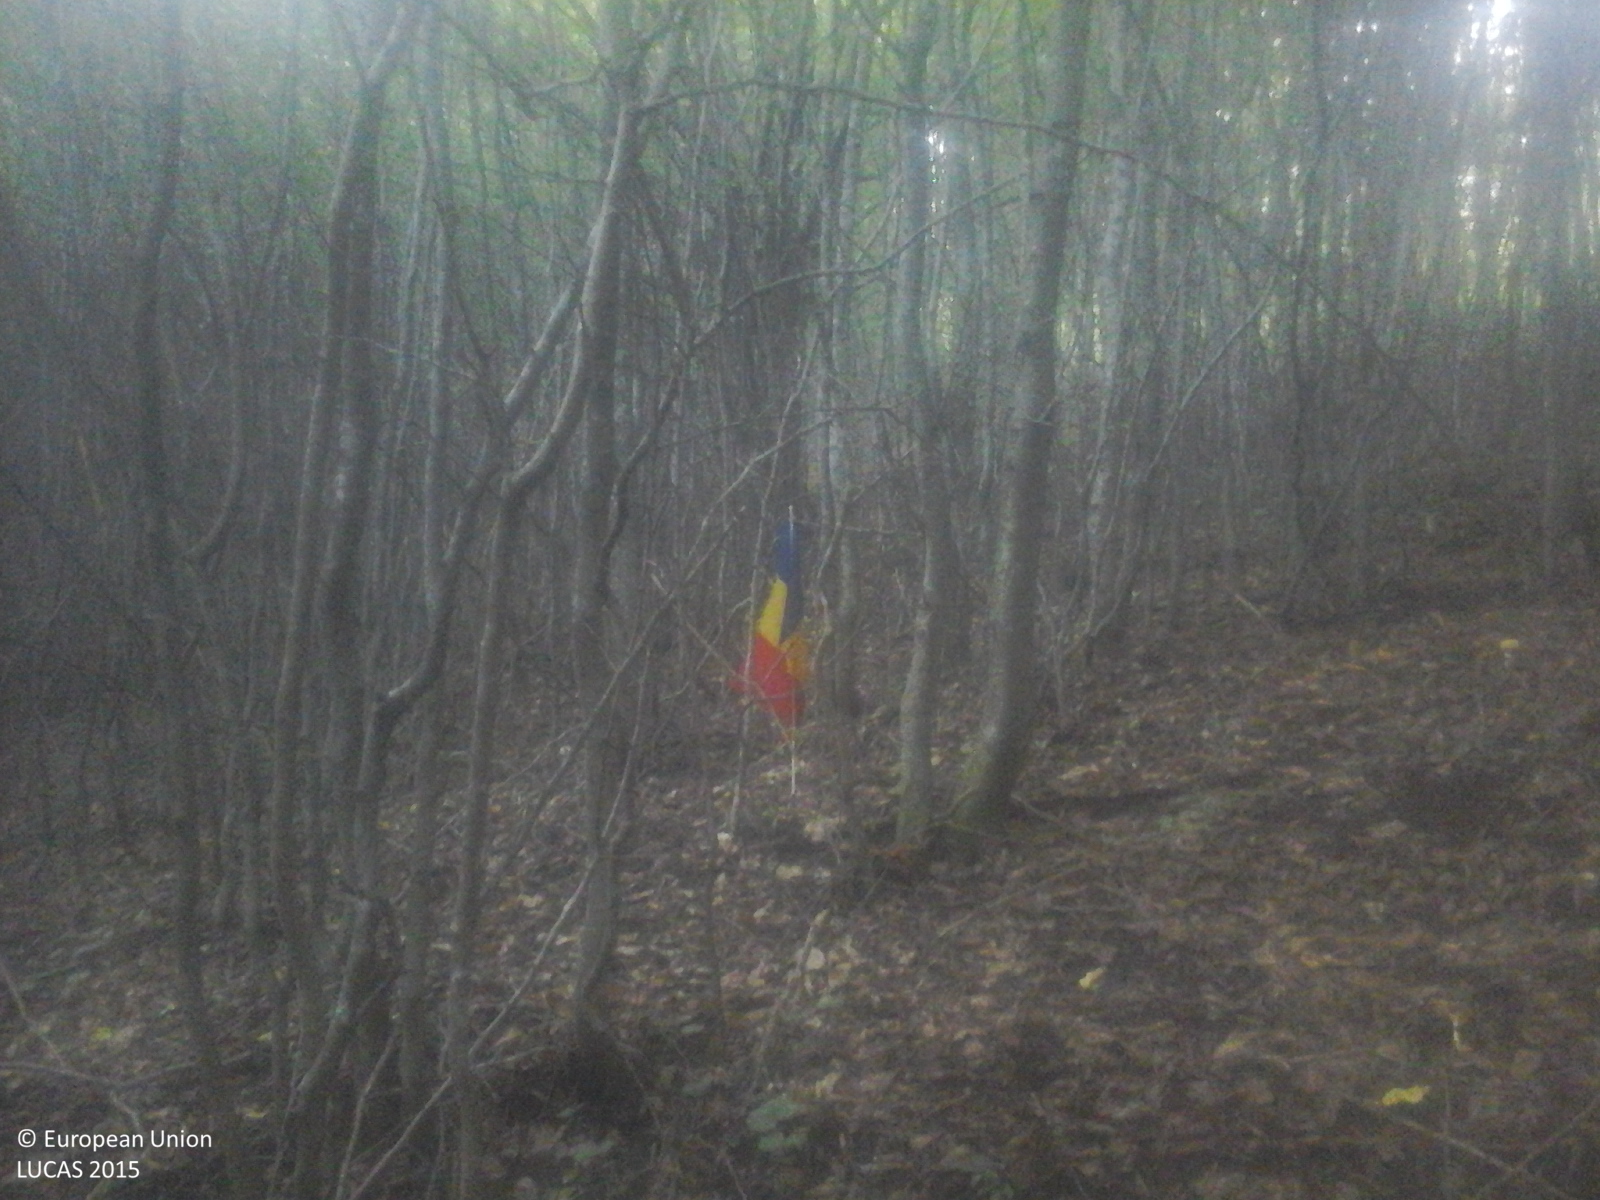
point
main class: Woodland
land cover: Broadleaved woodland
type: beech forest
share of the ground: > 75 %
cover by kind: broadleaved forest trees 100 %
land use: Forestry
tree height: > 5 m
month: October
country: RO
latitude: 46.4845
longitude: 23.5775
